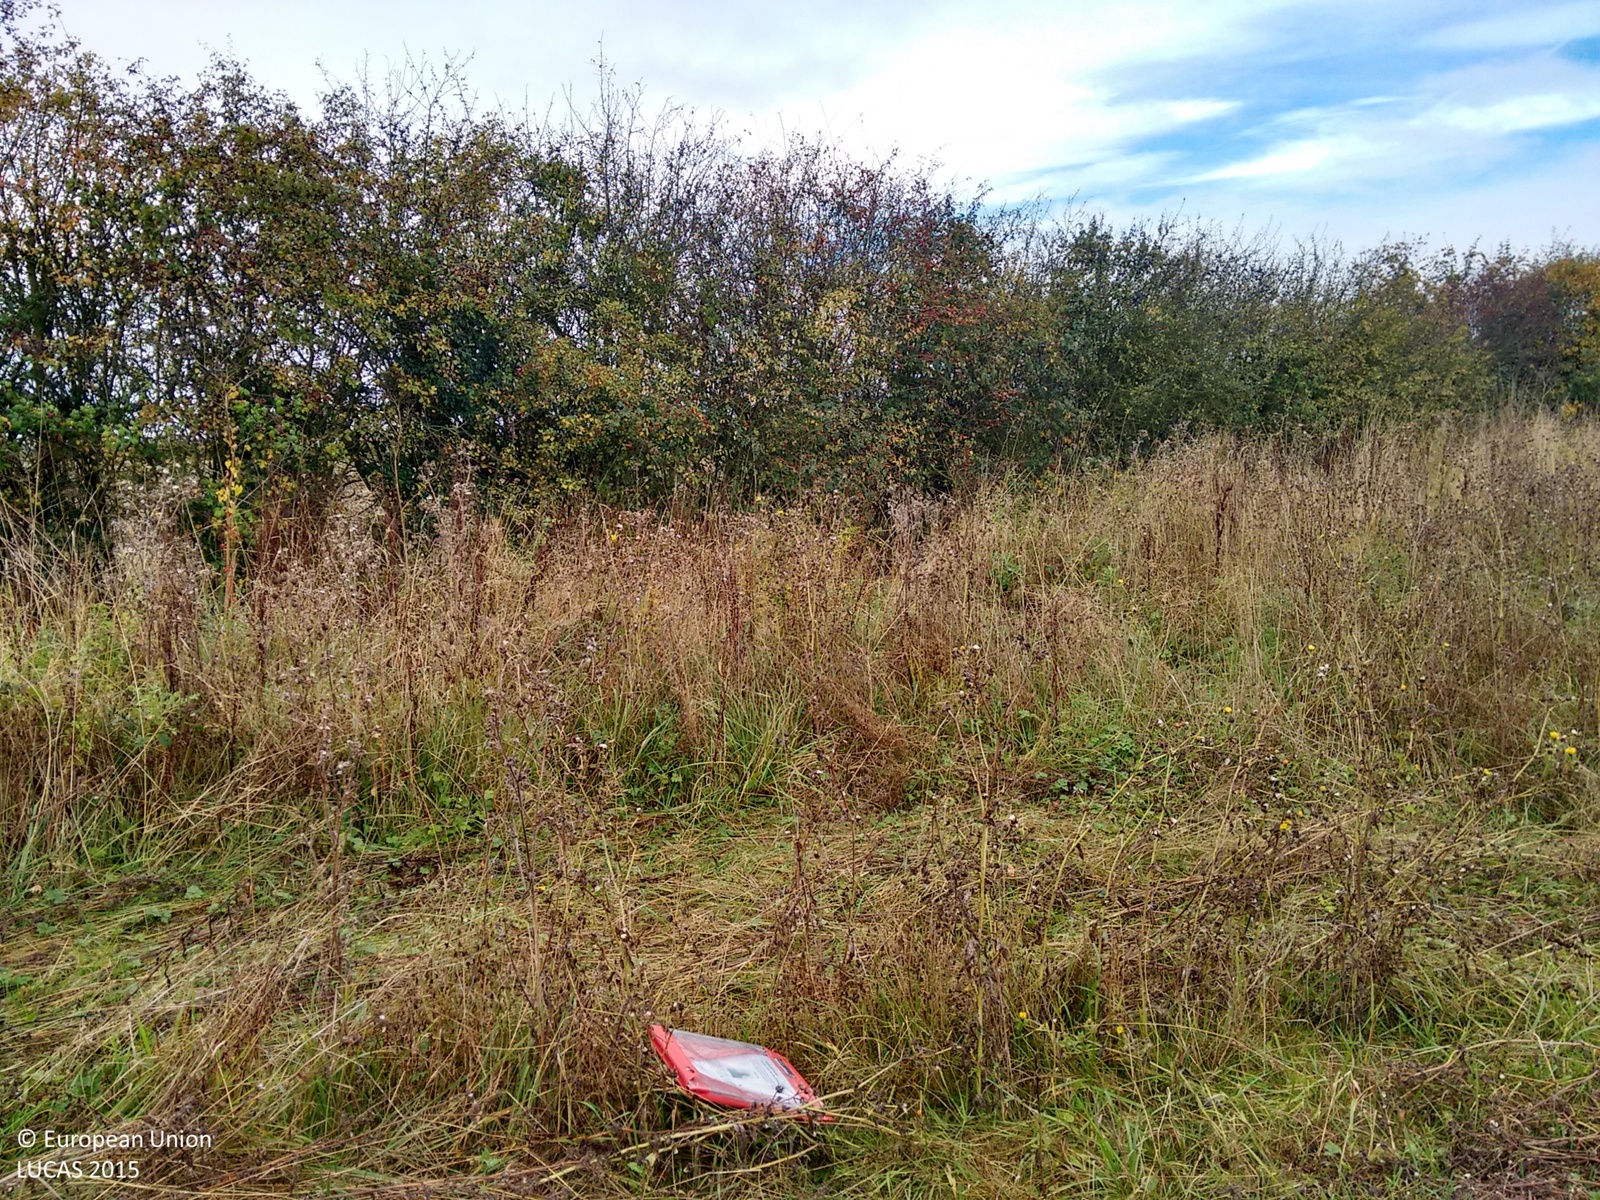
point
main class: Grassland
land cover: Grassland without tree/shrub cover
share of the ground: > 75 %
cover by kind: herbaceous plants 100 %
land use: Agriculture (excluding fallow land and kitchen gardens)
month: October
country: GB
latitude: 52.0151
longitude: -1.6959
